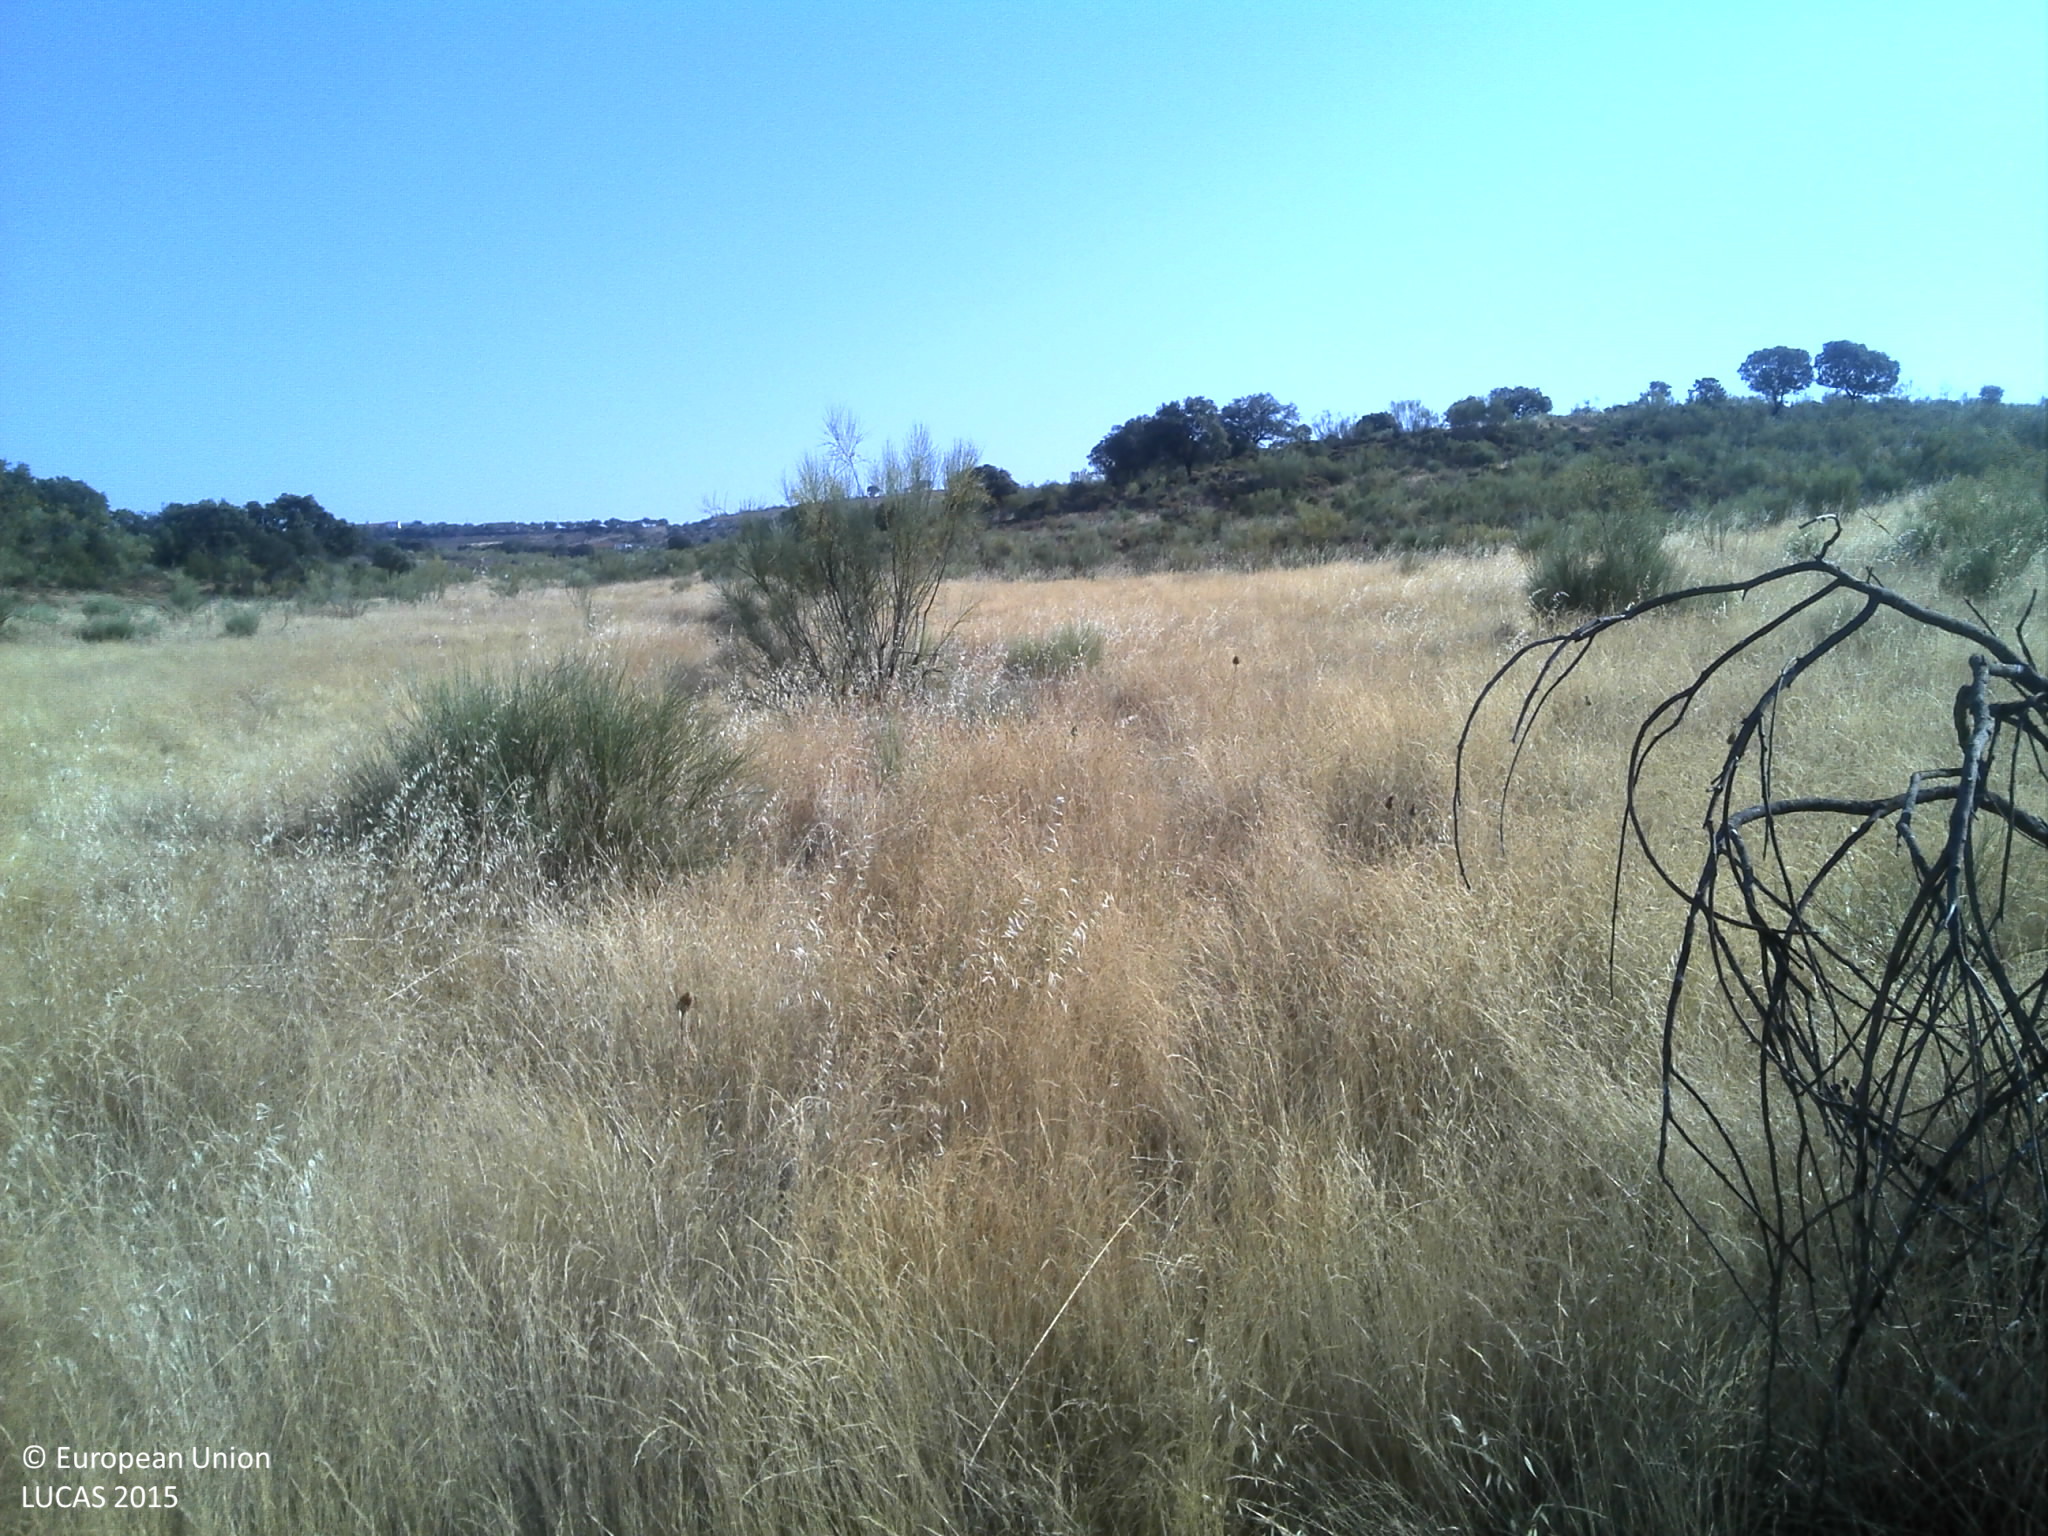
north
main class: Grassland
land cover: Grassland without tree/shrub cover
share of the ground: 50 - 75 %
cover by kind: herbaceous plants 65 %, unconsolidated bare surface 25 %, shrubs 5 %
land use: Agriculture (excluding fallow land and kitchen gardens)
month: June
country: PT
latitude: 39.7155
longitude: -7.0834
